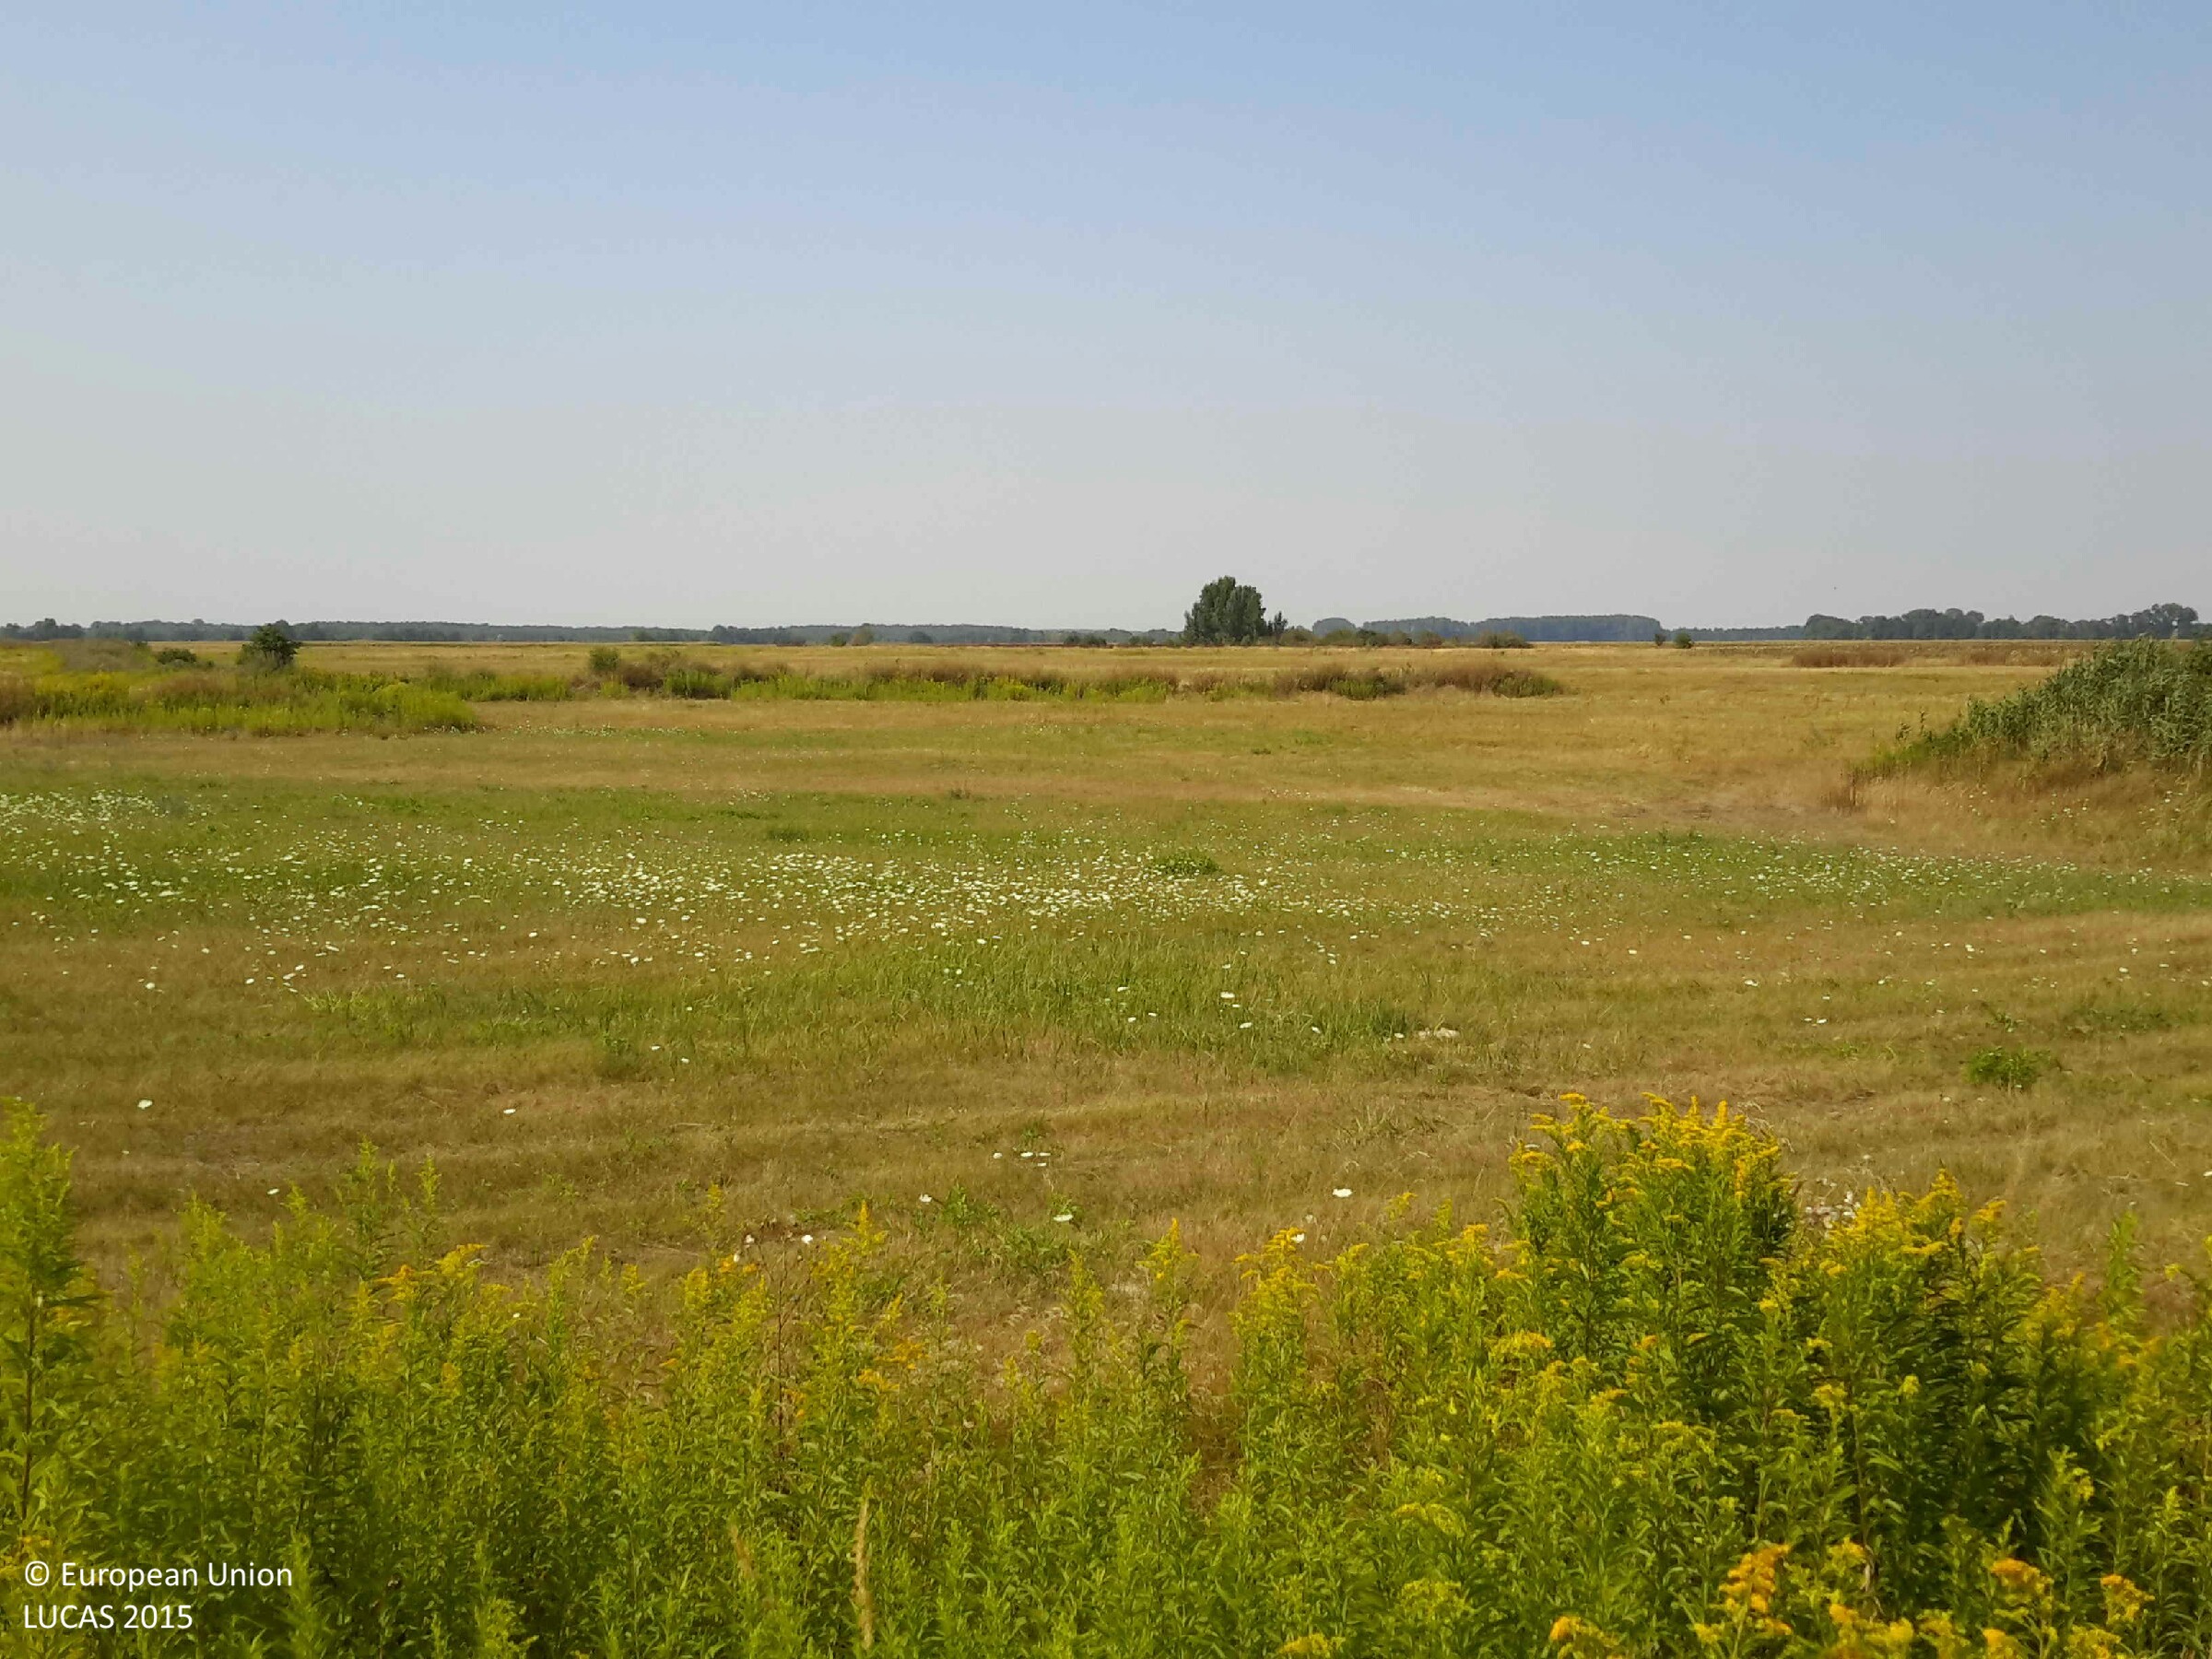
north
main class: Grassland
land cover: Spontaneously vegetated surfaces
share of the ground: > 75 %
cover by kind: herbaceous plants 100 %
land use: Fallow land
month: August
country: HU
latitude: 47.9073
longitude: 17.3265
